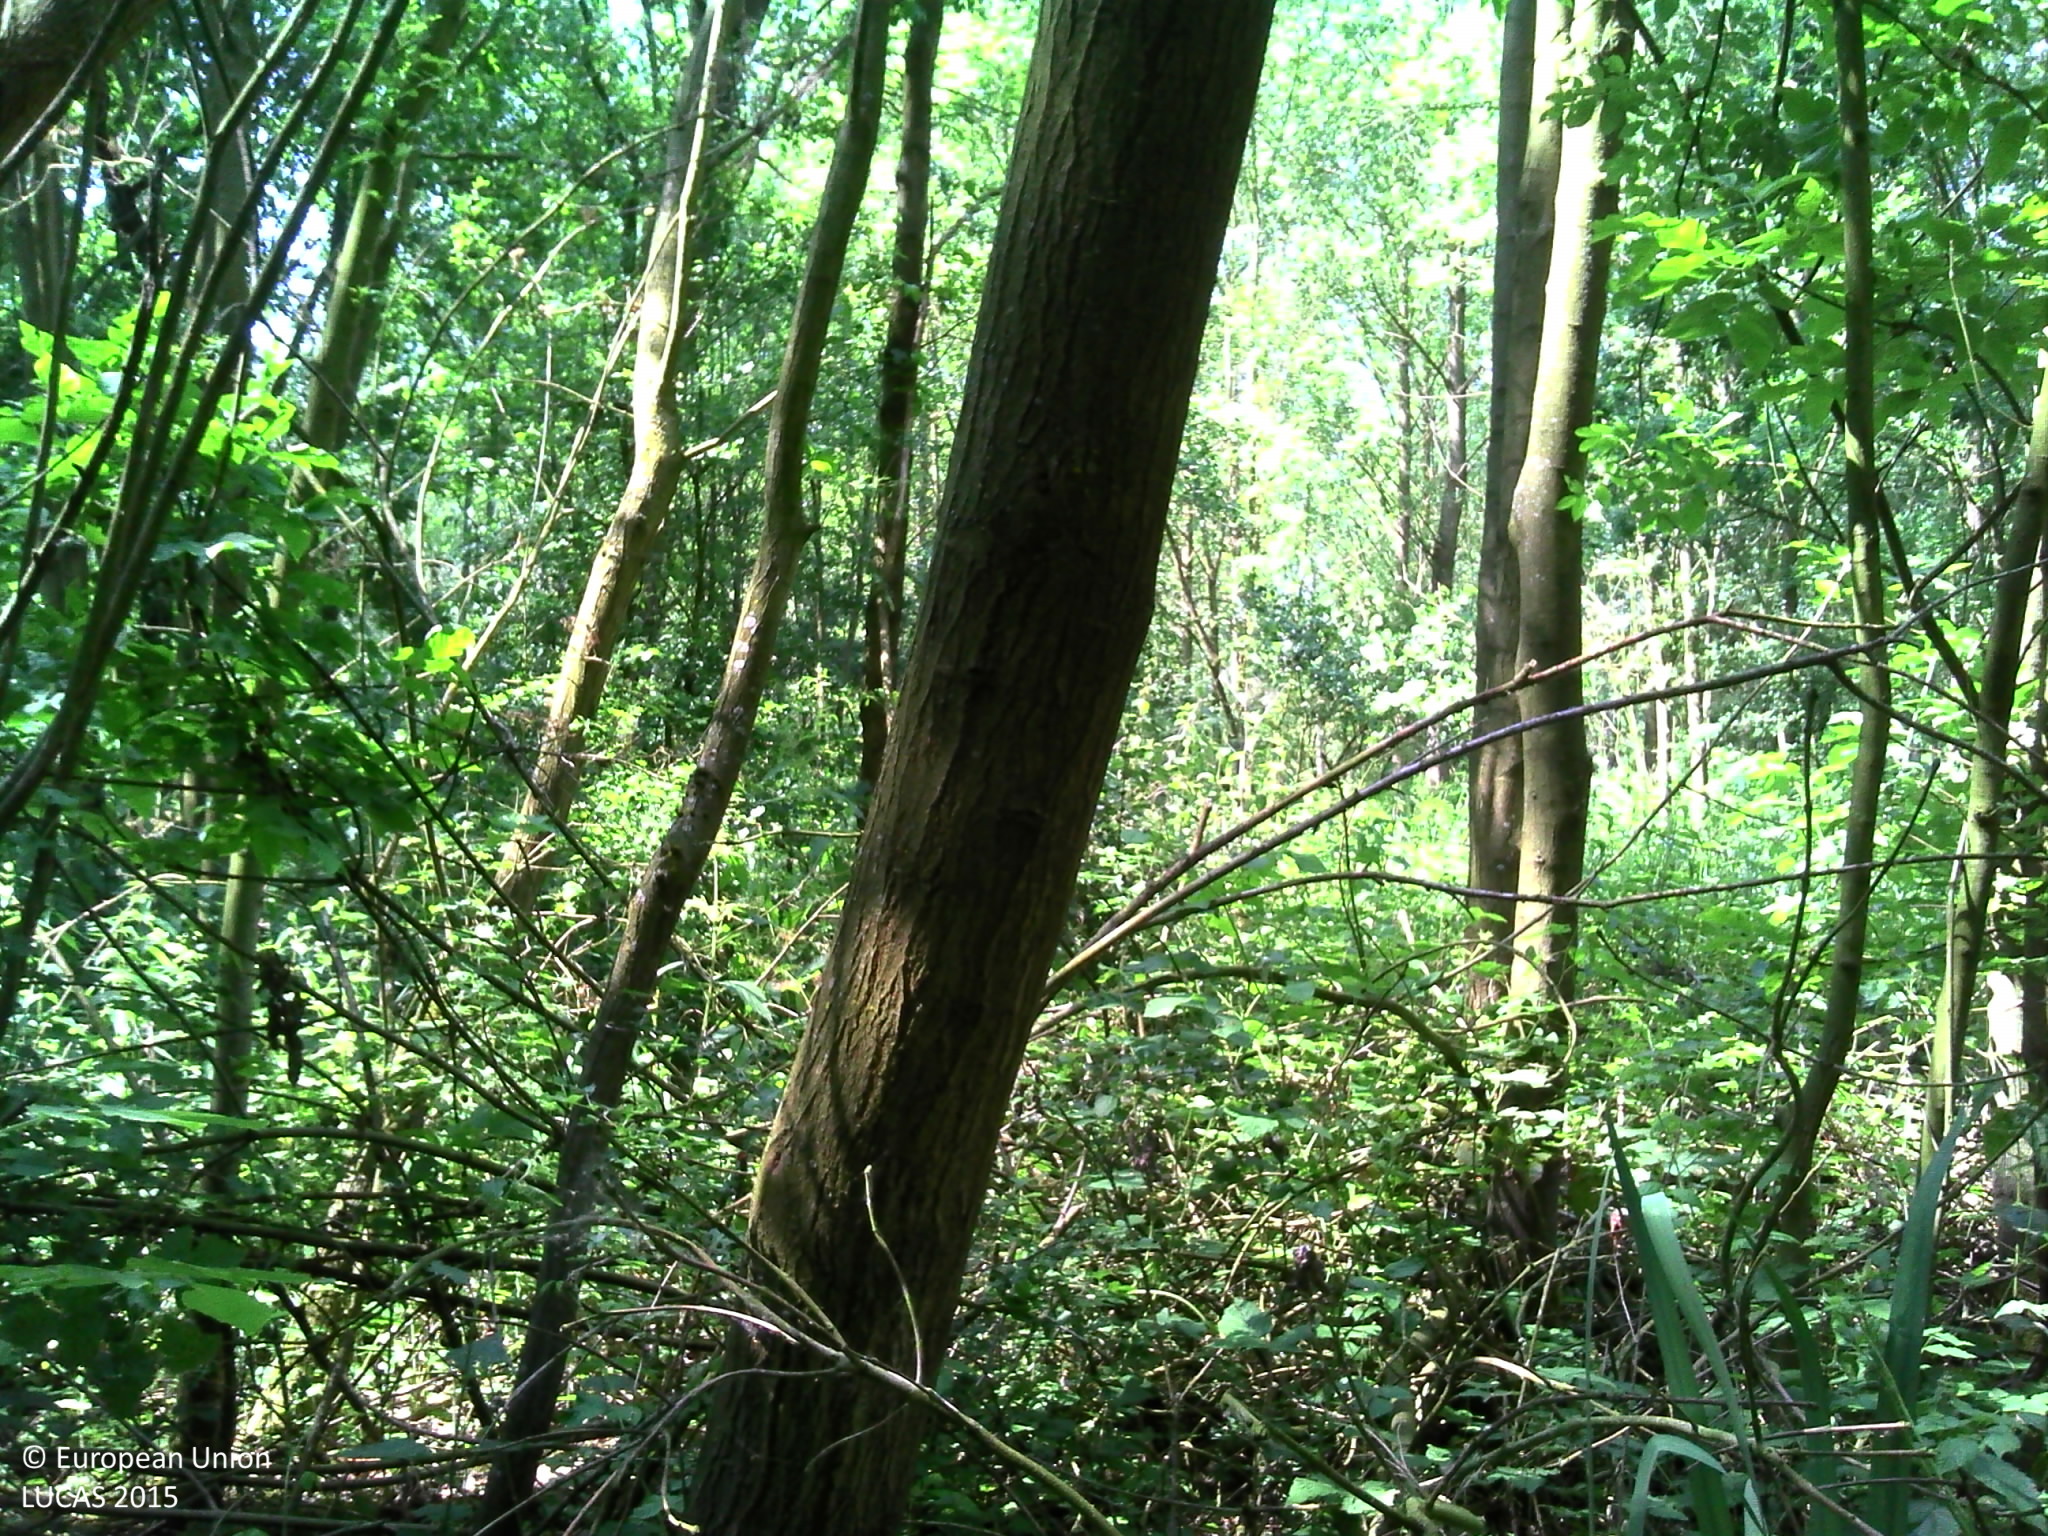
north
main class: Woodland
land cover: Broadleaved woodland
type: acidophilous oak and oak-birch forest
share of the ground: > 75 %
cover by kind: broadleaved forest trees 100 %
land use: Forestry
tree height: > 5 m
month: June
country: BE
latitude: 51.0340
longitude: 3.9619
